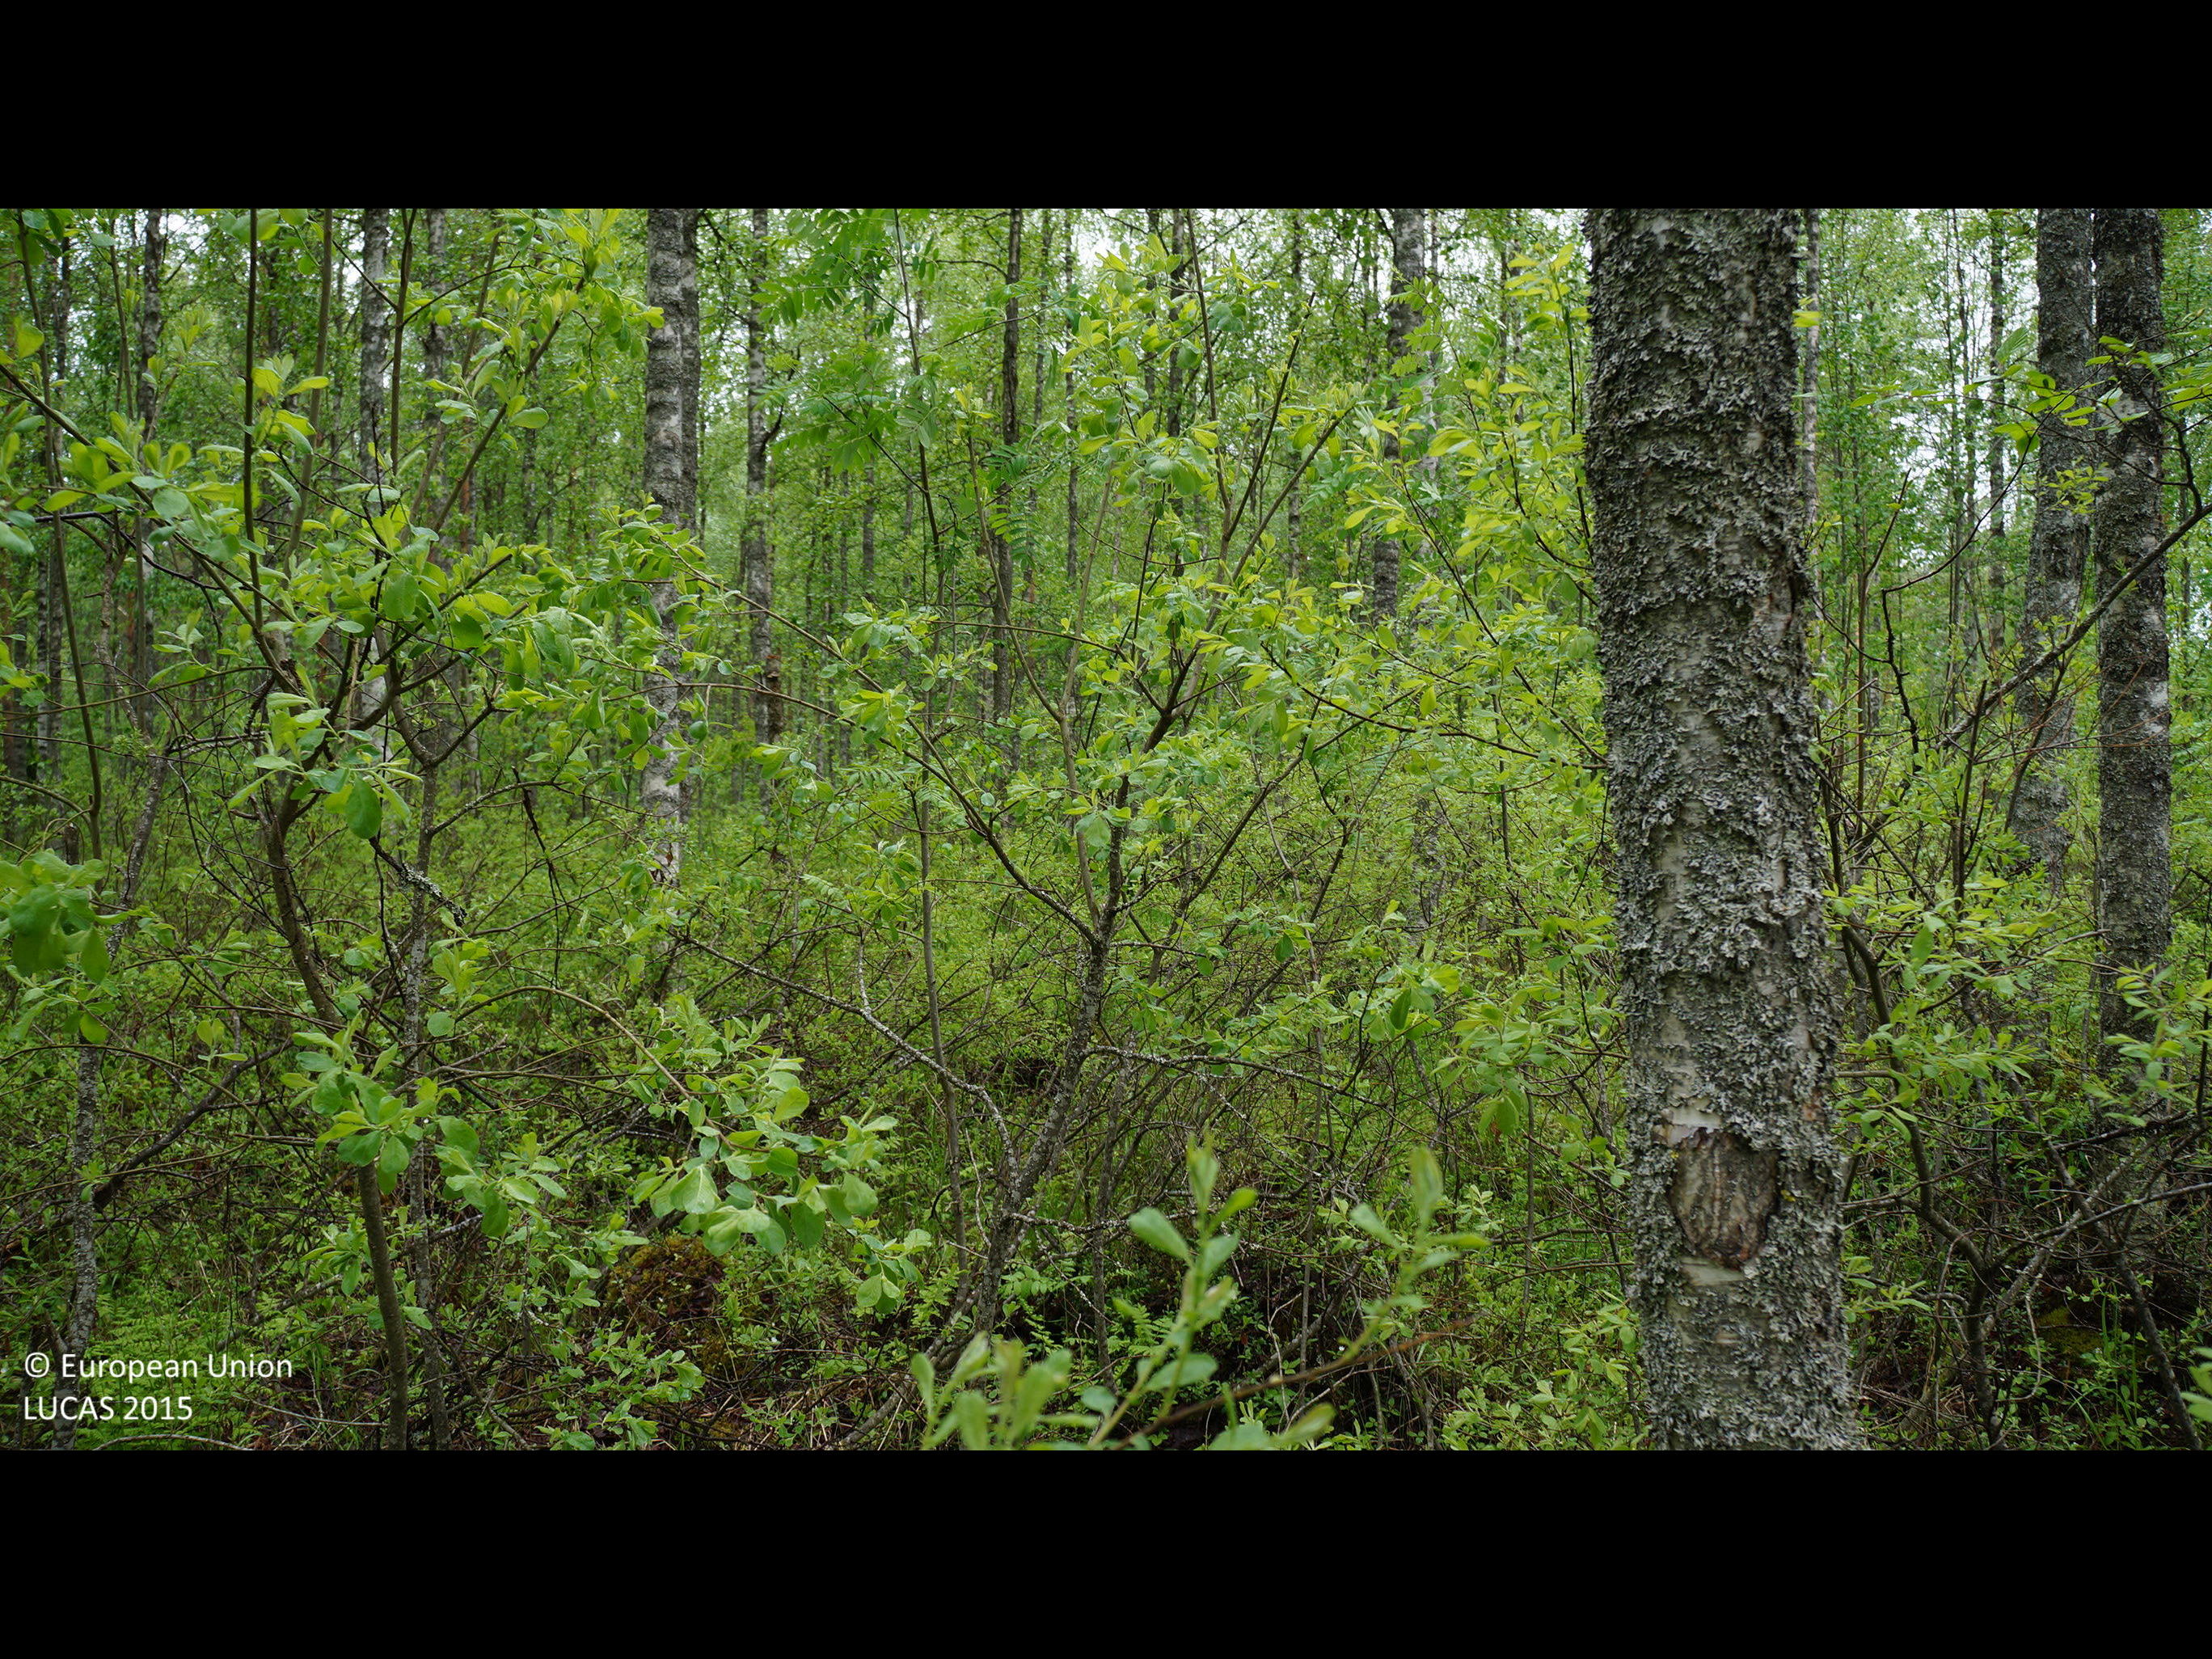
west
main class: Woodland
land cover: Broadleaved woodland
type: boreal forest
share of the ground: 50 - 75 %
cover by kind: broadleaved forest trees 65 %, shrubs 25 %, coniferous forest trees 5 %, herbaceous plants 5 %
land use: Forestry
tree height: > 5 m
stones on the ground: < 10 %
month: June
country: FI
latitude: 64.2772
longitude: 25.3077
